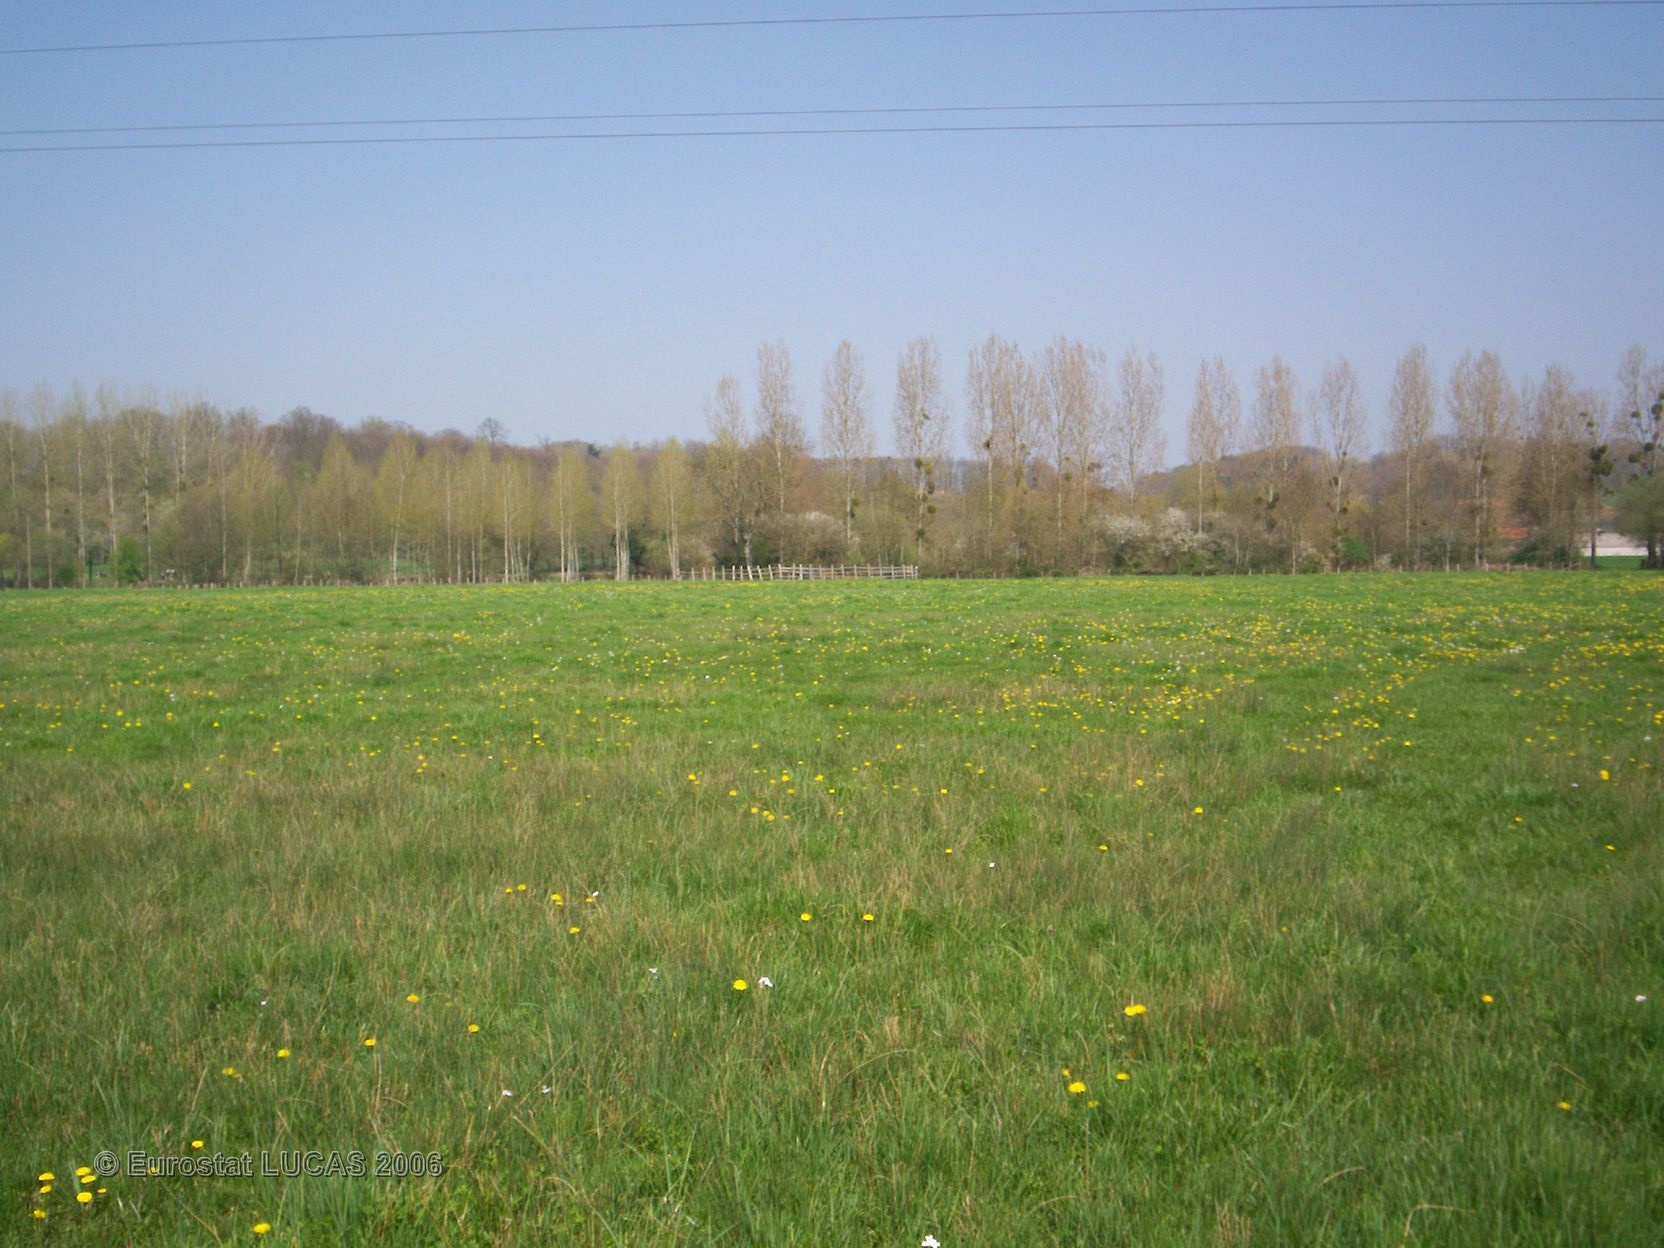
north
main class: Grassland
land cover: Grassland without tree/shrub cover
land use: Agriculture (excluding fallow land and kitchen gardens)
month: April
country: FR
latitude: 48.0380
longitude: 0.3857
